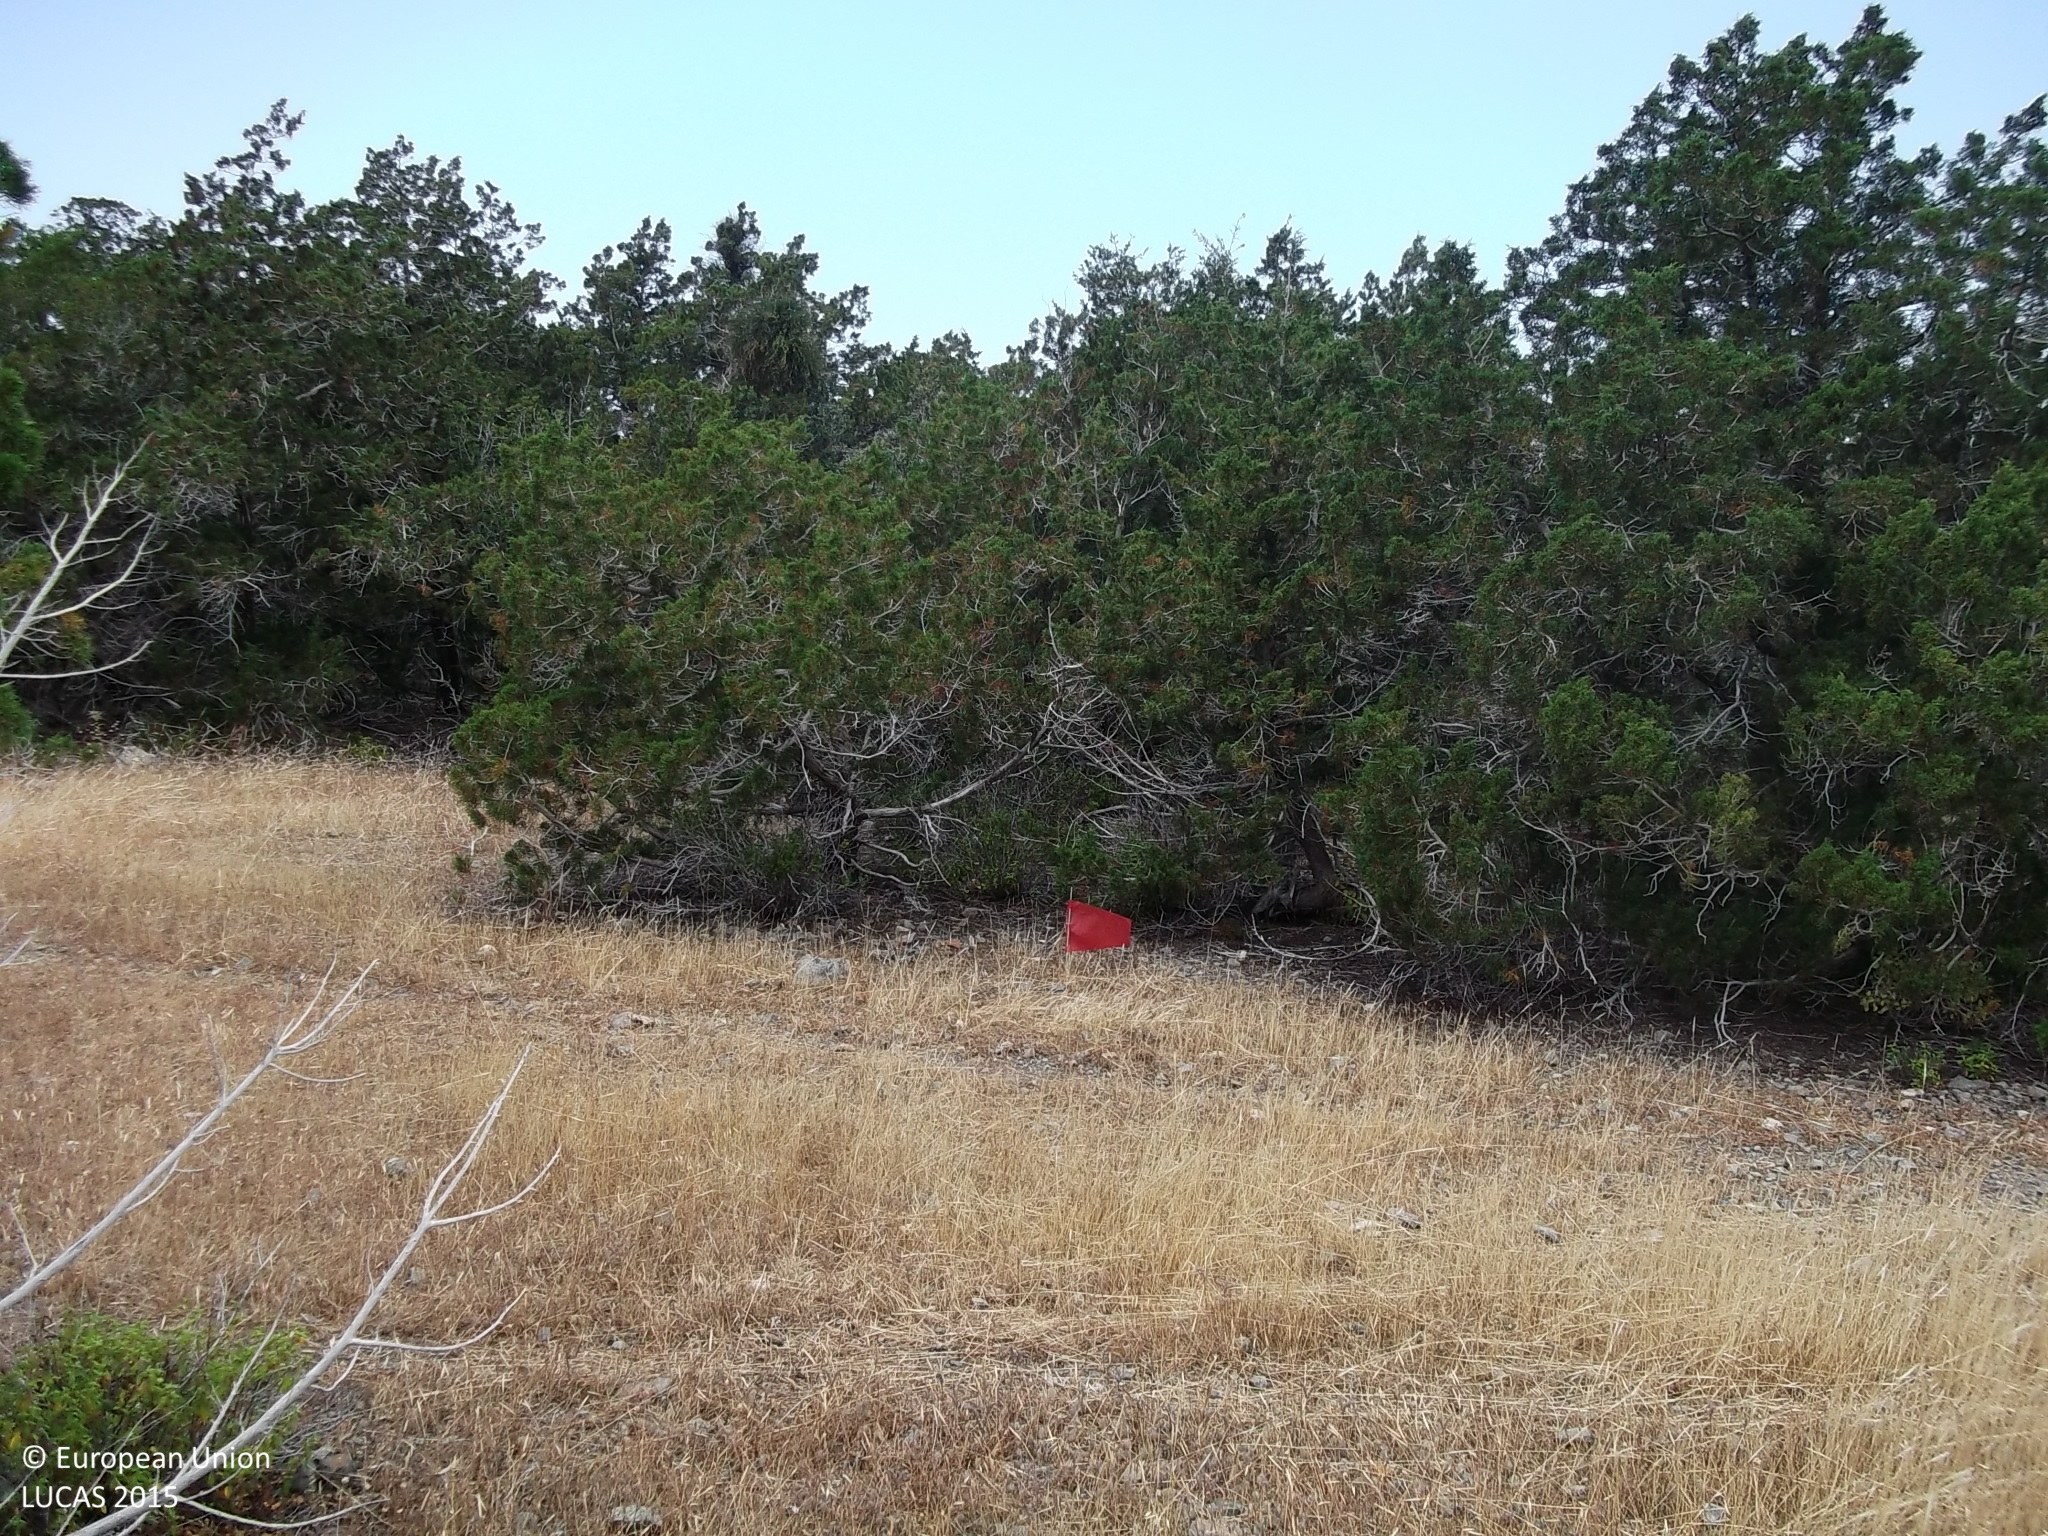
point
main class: Woodland
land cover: Other coniferous woodland
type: coniferous forest of the mediterranean region
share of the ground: > 75 %
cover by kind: coniferous forest trees 75 %, herbaceous plants 20 %, unconsolidated bare surface 5 %
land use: Agriculture (excluding fallow land and kitchen gardens)
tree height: < 5 m
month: May
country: CY
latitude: 35.0264
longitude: 32.2991
